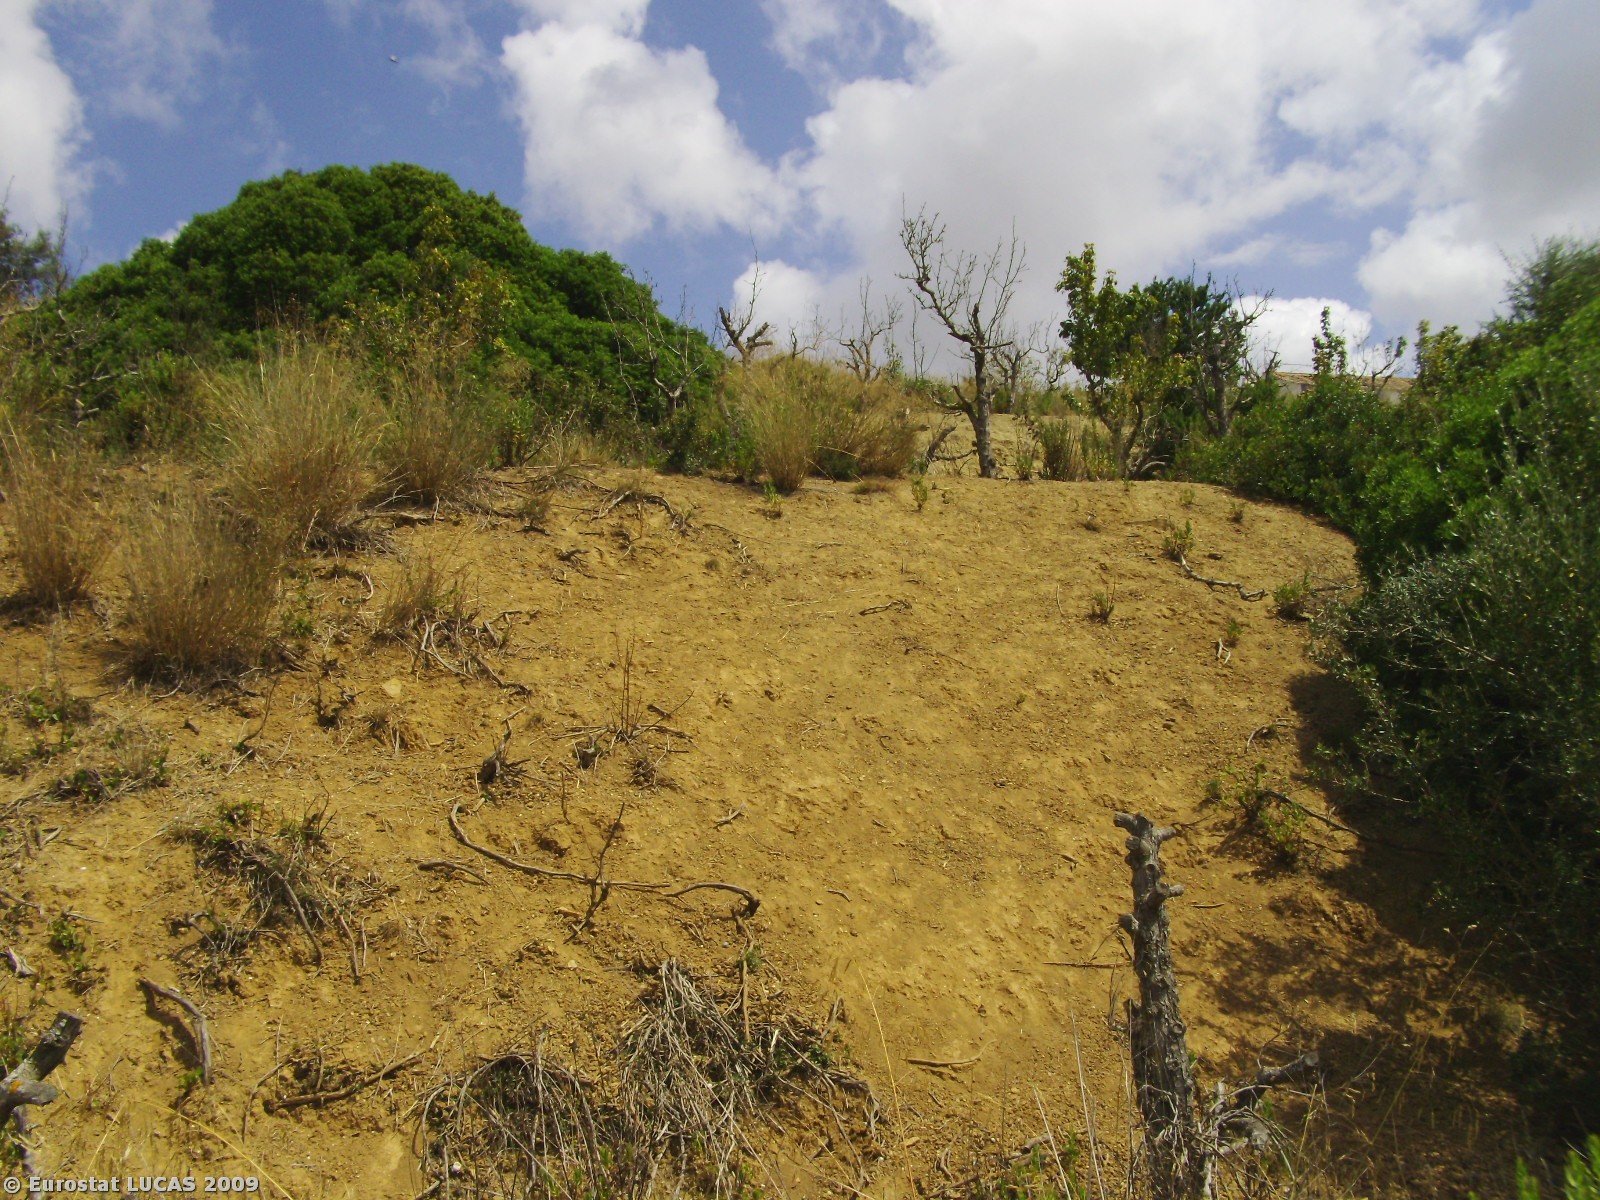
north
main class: Shrubland
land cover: Shrubland with sparse tree cover
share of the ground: 50 - 75 %
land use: Unused
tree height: < 5 m
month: July
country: PT
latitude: 39.0968
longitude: -9.2688
